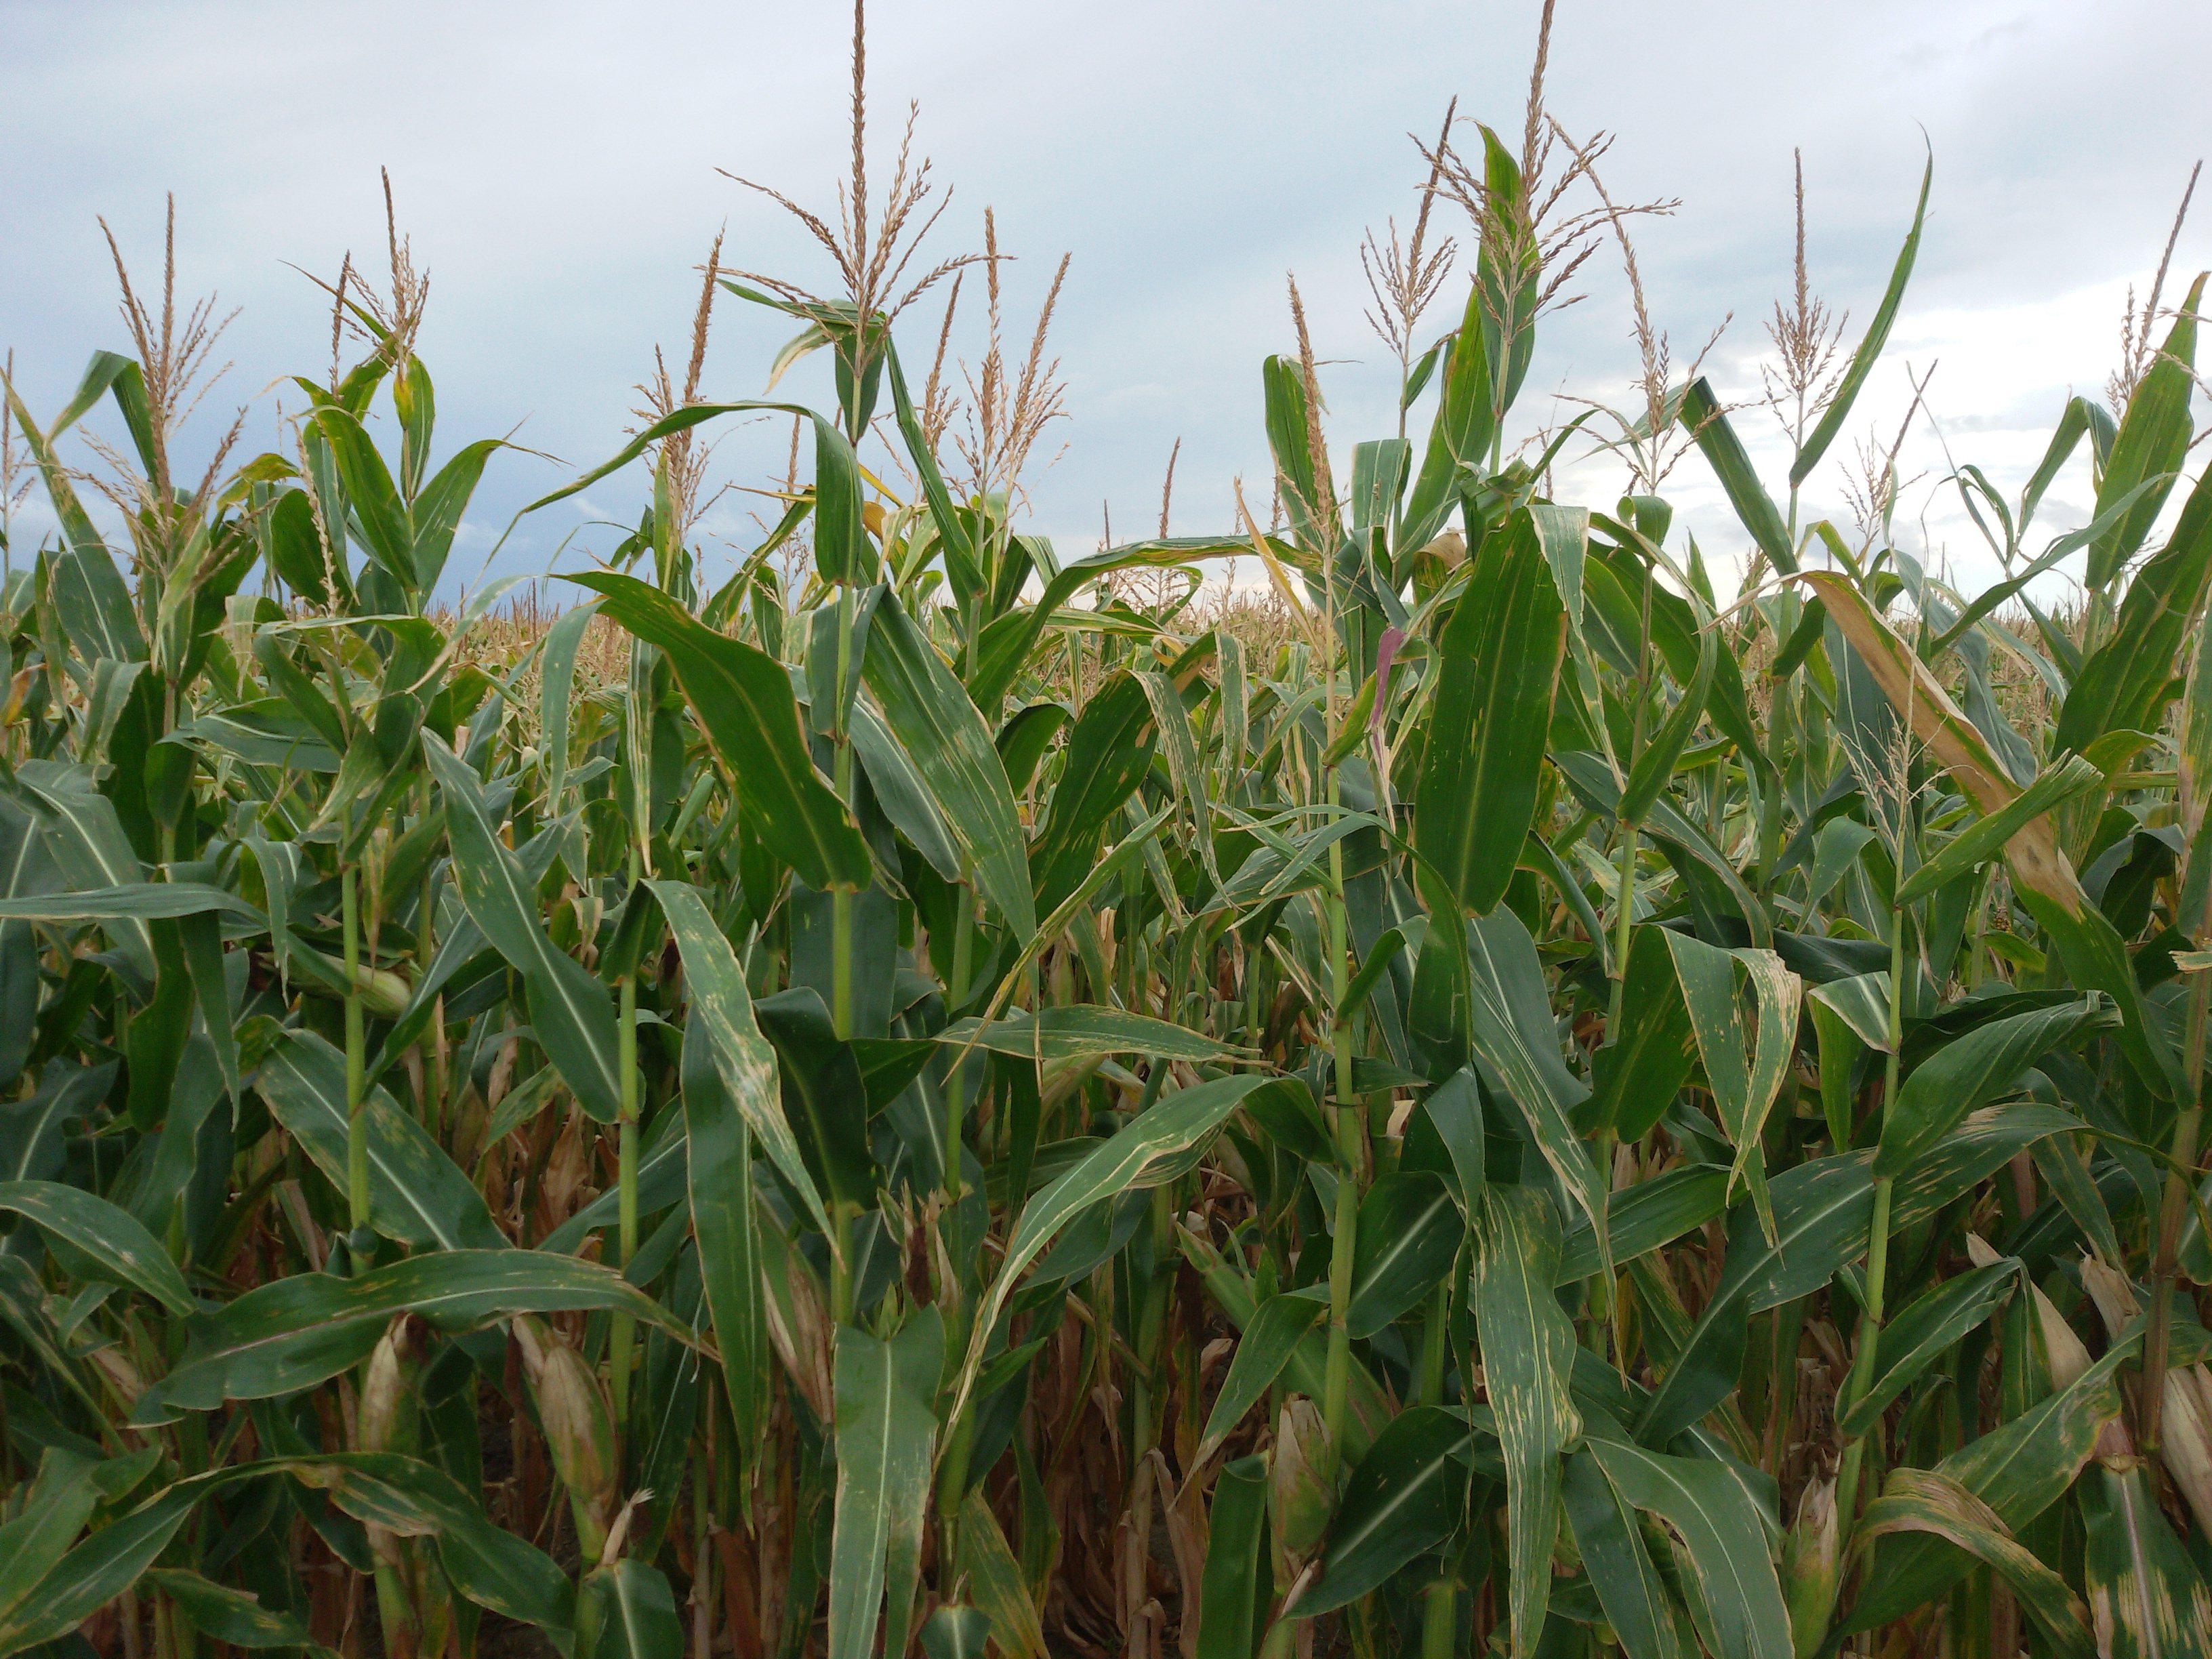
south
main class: Cropland
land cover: Maize
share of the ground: > 75 %
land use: Agriculture (excluding fallow land and kitchen gardens)
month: August
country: PL
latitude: 51.8789
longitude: 17.9031
